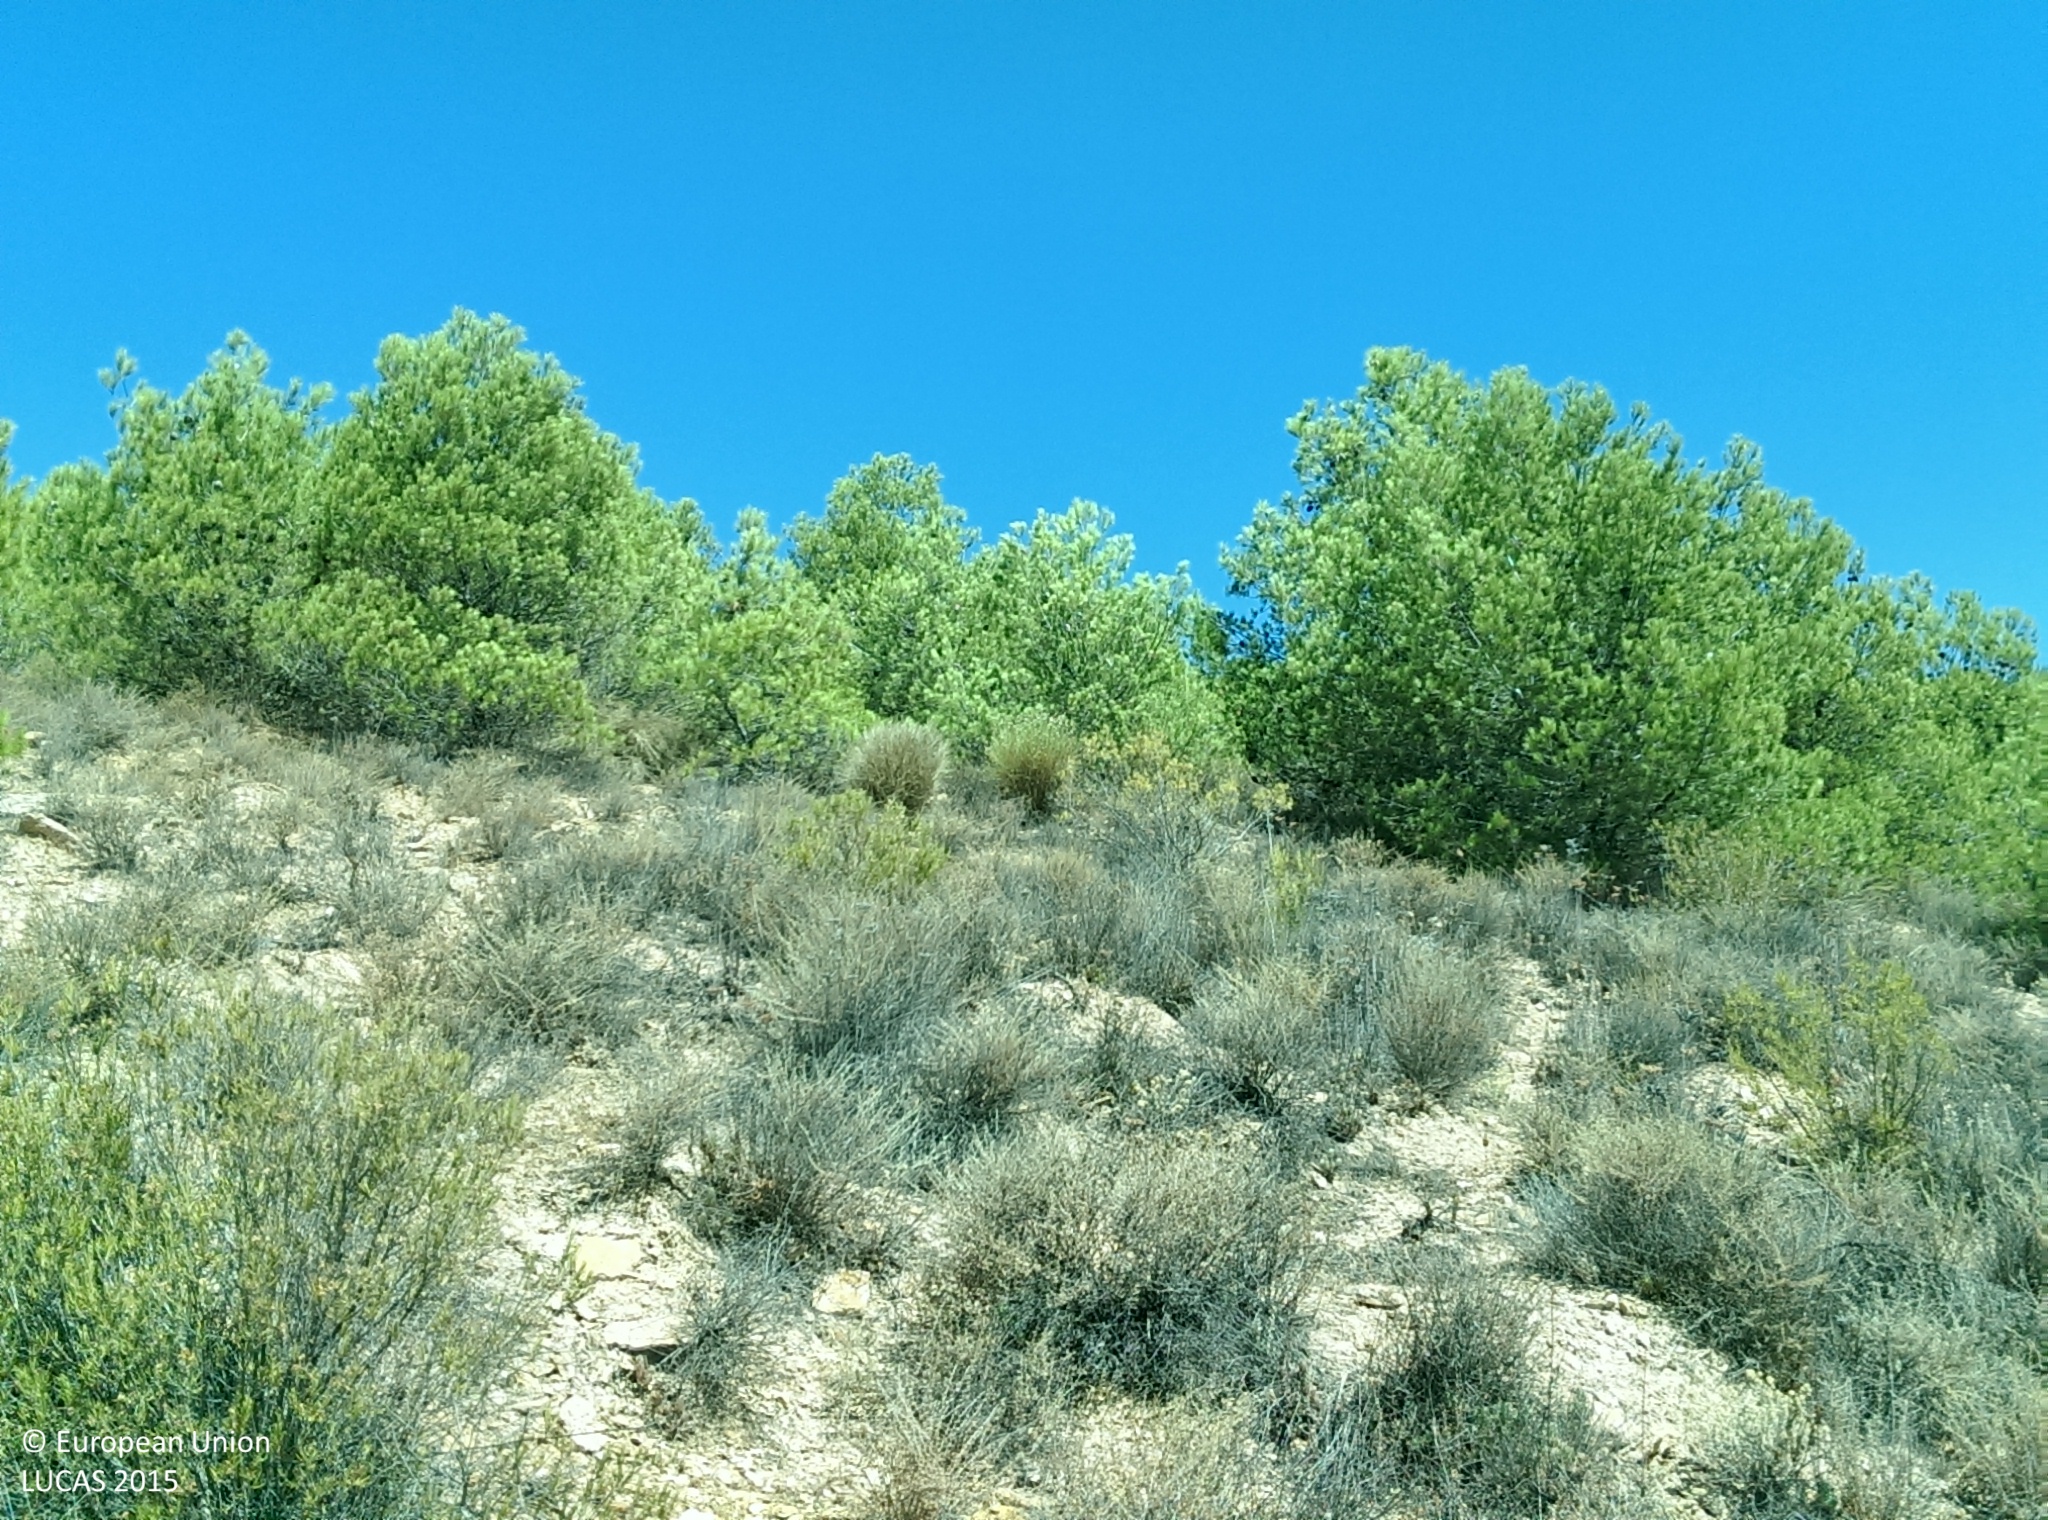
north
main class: Shrubland
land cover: Shrubland without tree cover
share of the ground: 50 - 75 %
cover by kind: shrubs 60 %, herbaceous plants 20 %, unconsolidated bare surface 20 %
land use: Semi-natural and natural areas not in use
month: August
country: ES
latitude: 36.8178
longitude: -3.1065
